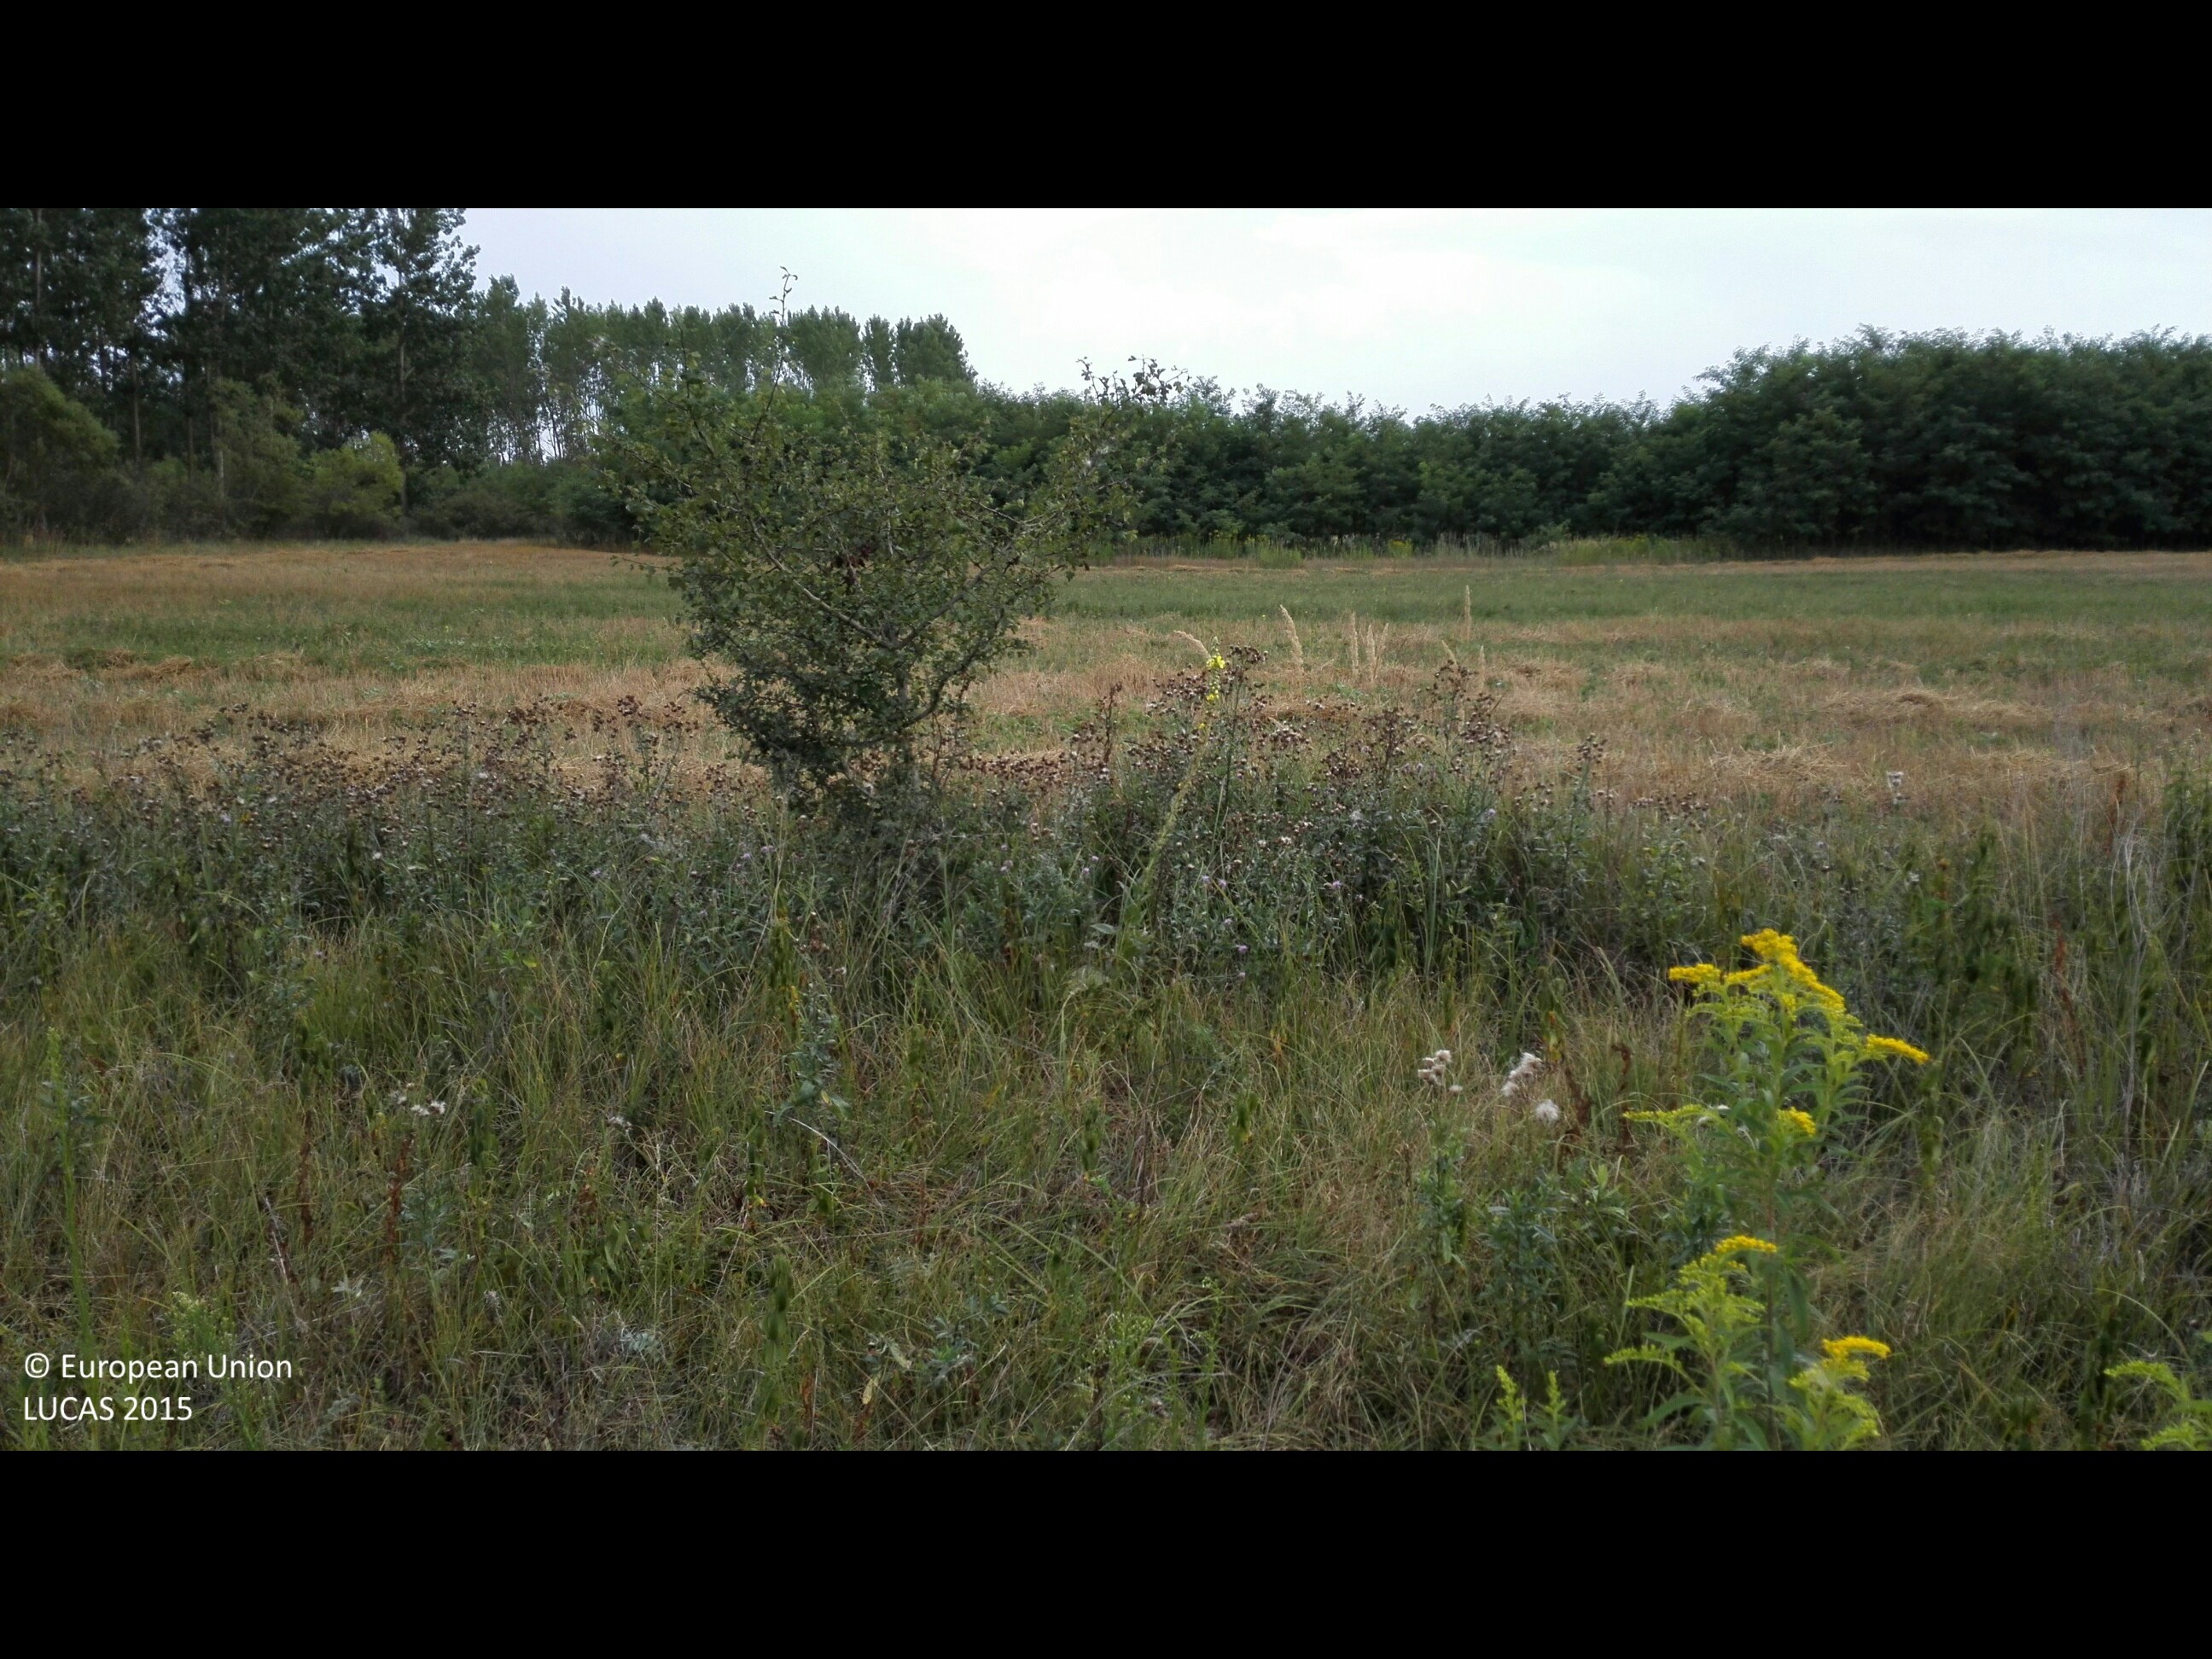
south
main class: Grassland
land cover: Spontaneously vegetated surfaces
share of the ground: > 75 %
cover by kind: herbaceous plants 100 %
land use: Fallow land
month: August
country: HU
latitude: 47.6009
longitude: 22.0075
